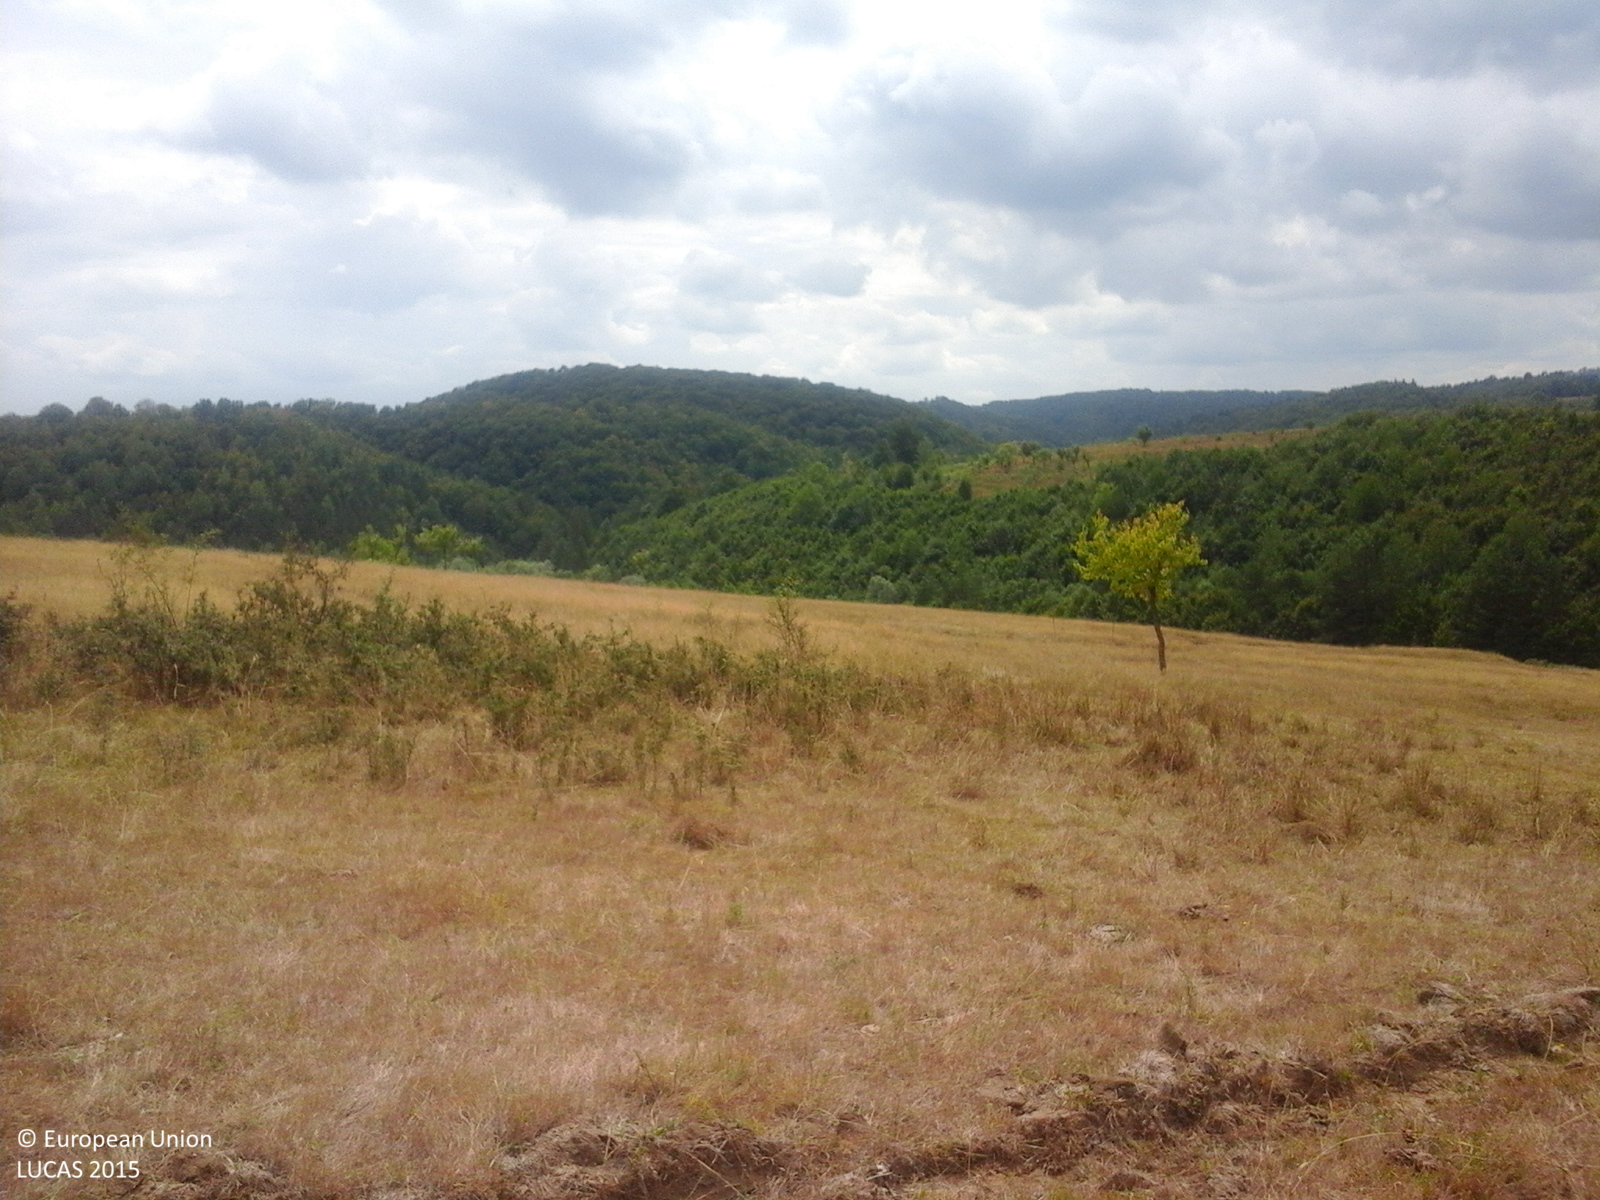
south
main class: Grassland
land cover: Grassland without tree/shrub cover
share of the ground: > 75 %
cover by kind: herbaceous plants 100 %
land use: Agriculture (excluding fallow land and kitchen gardens)
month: August
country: RO
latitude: 44.8955
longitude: 22.7199
